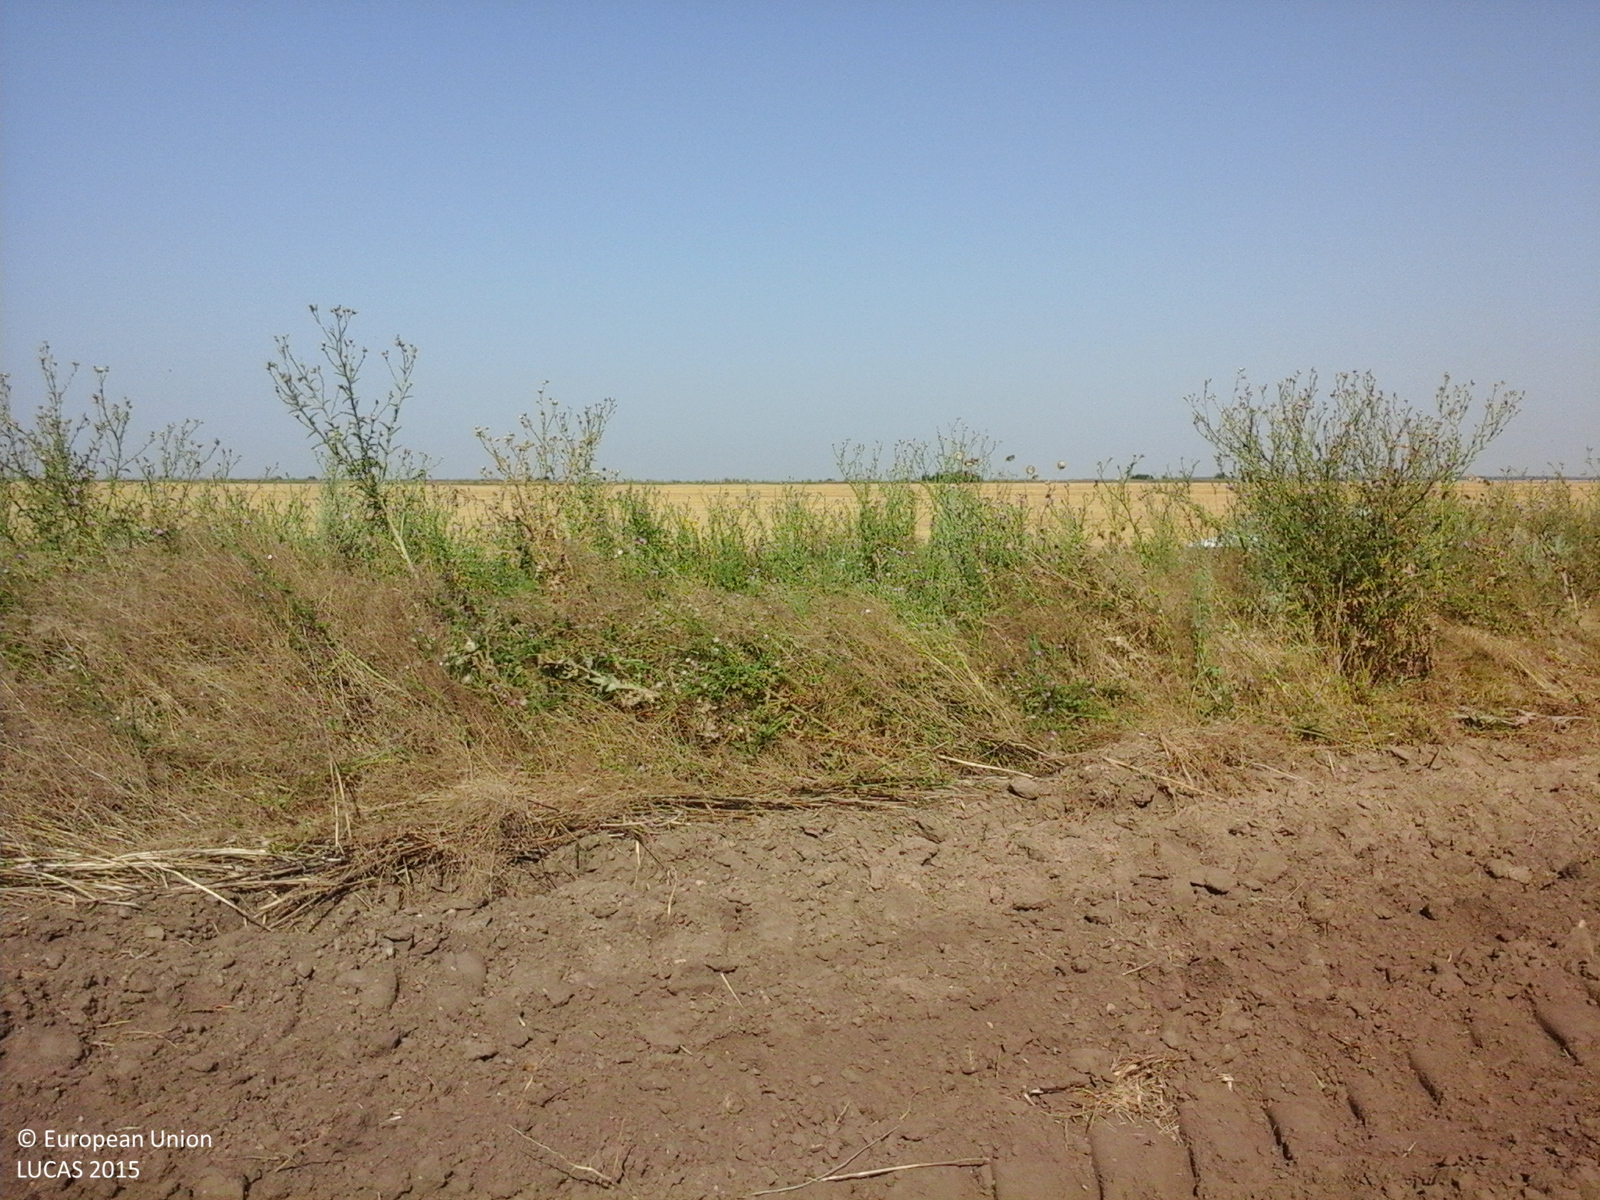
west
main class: Cropland
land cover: Rape and turnip rape
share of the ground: < 10 %
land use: Agriculture (excluding fallow land and kitchen gardens)
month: July
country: RO
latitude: 44.3175
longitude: 27.5319
